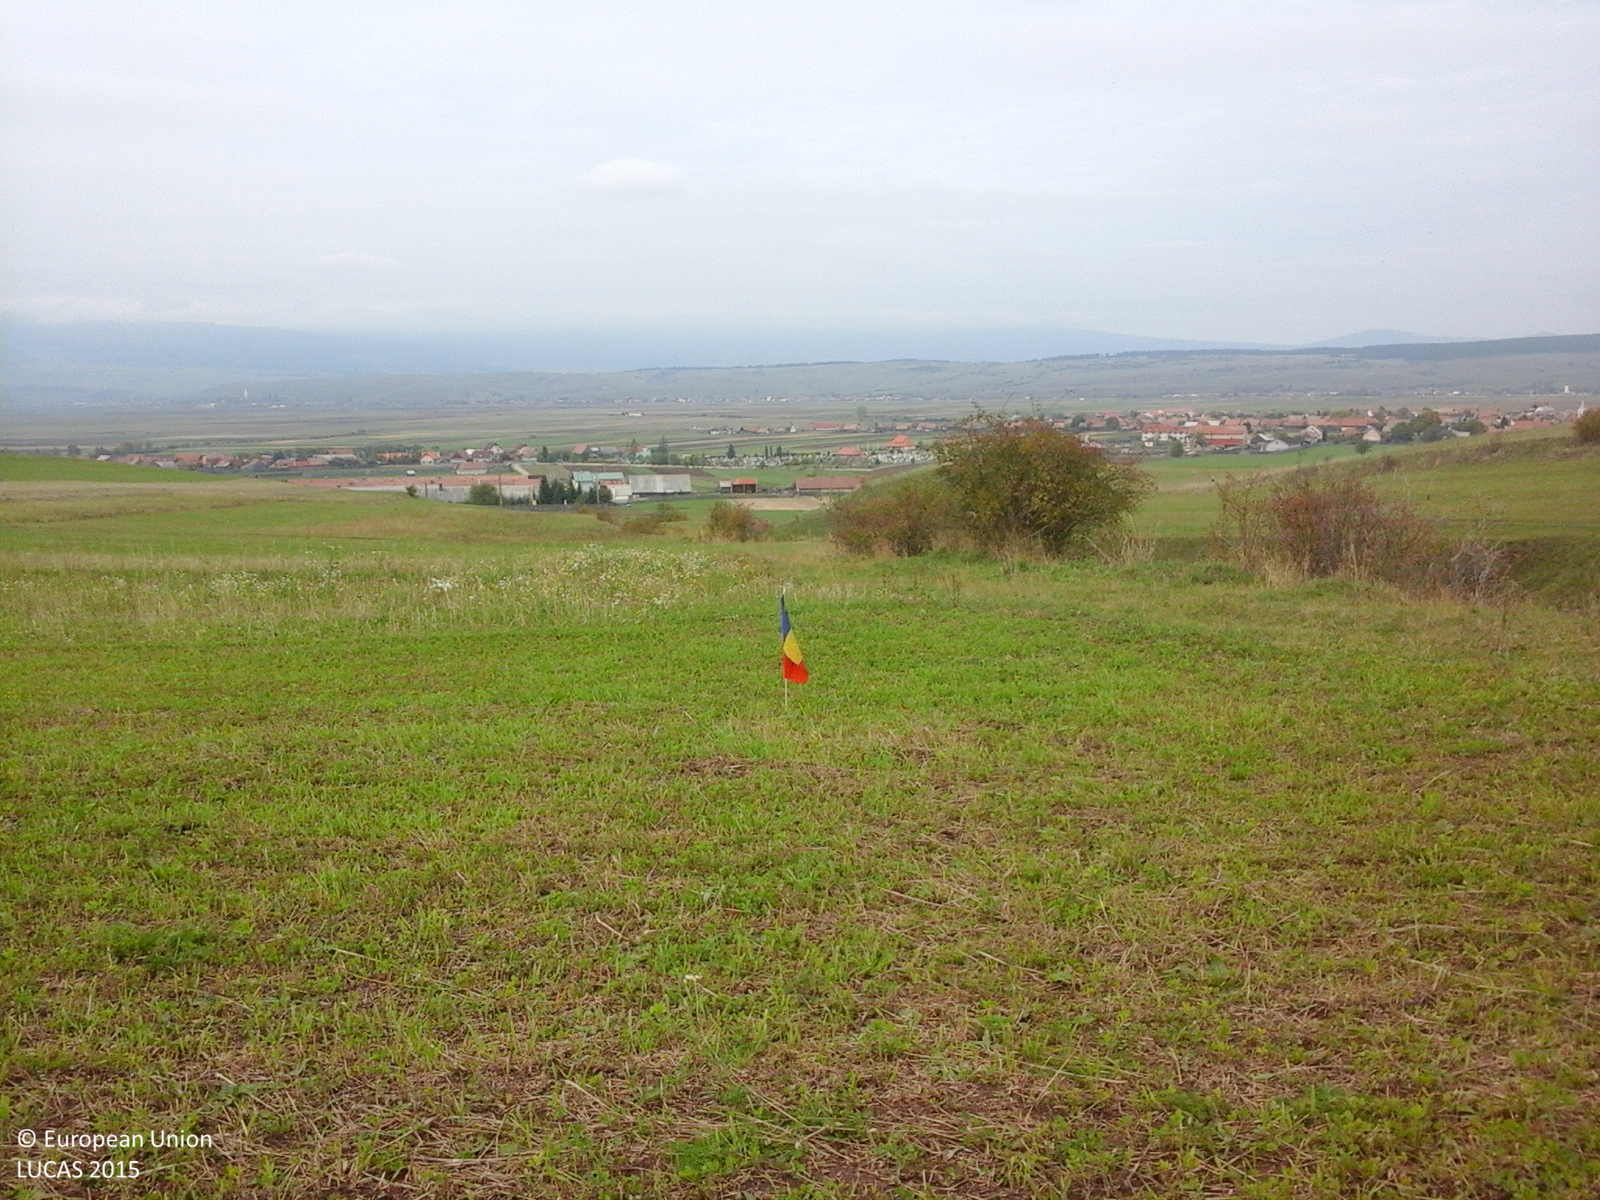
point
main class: Cropland
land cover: Lucerne
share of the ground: > 75 %
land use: Agriculture (excluding fallow land and kitchen gardens)
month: October
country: RO
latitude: 46.4431
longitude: 25.8542
